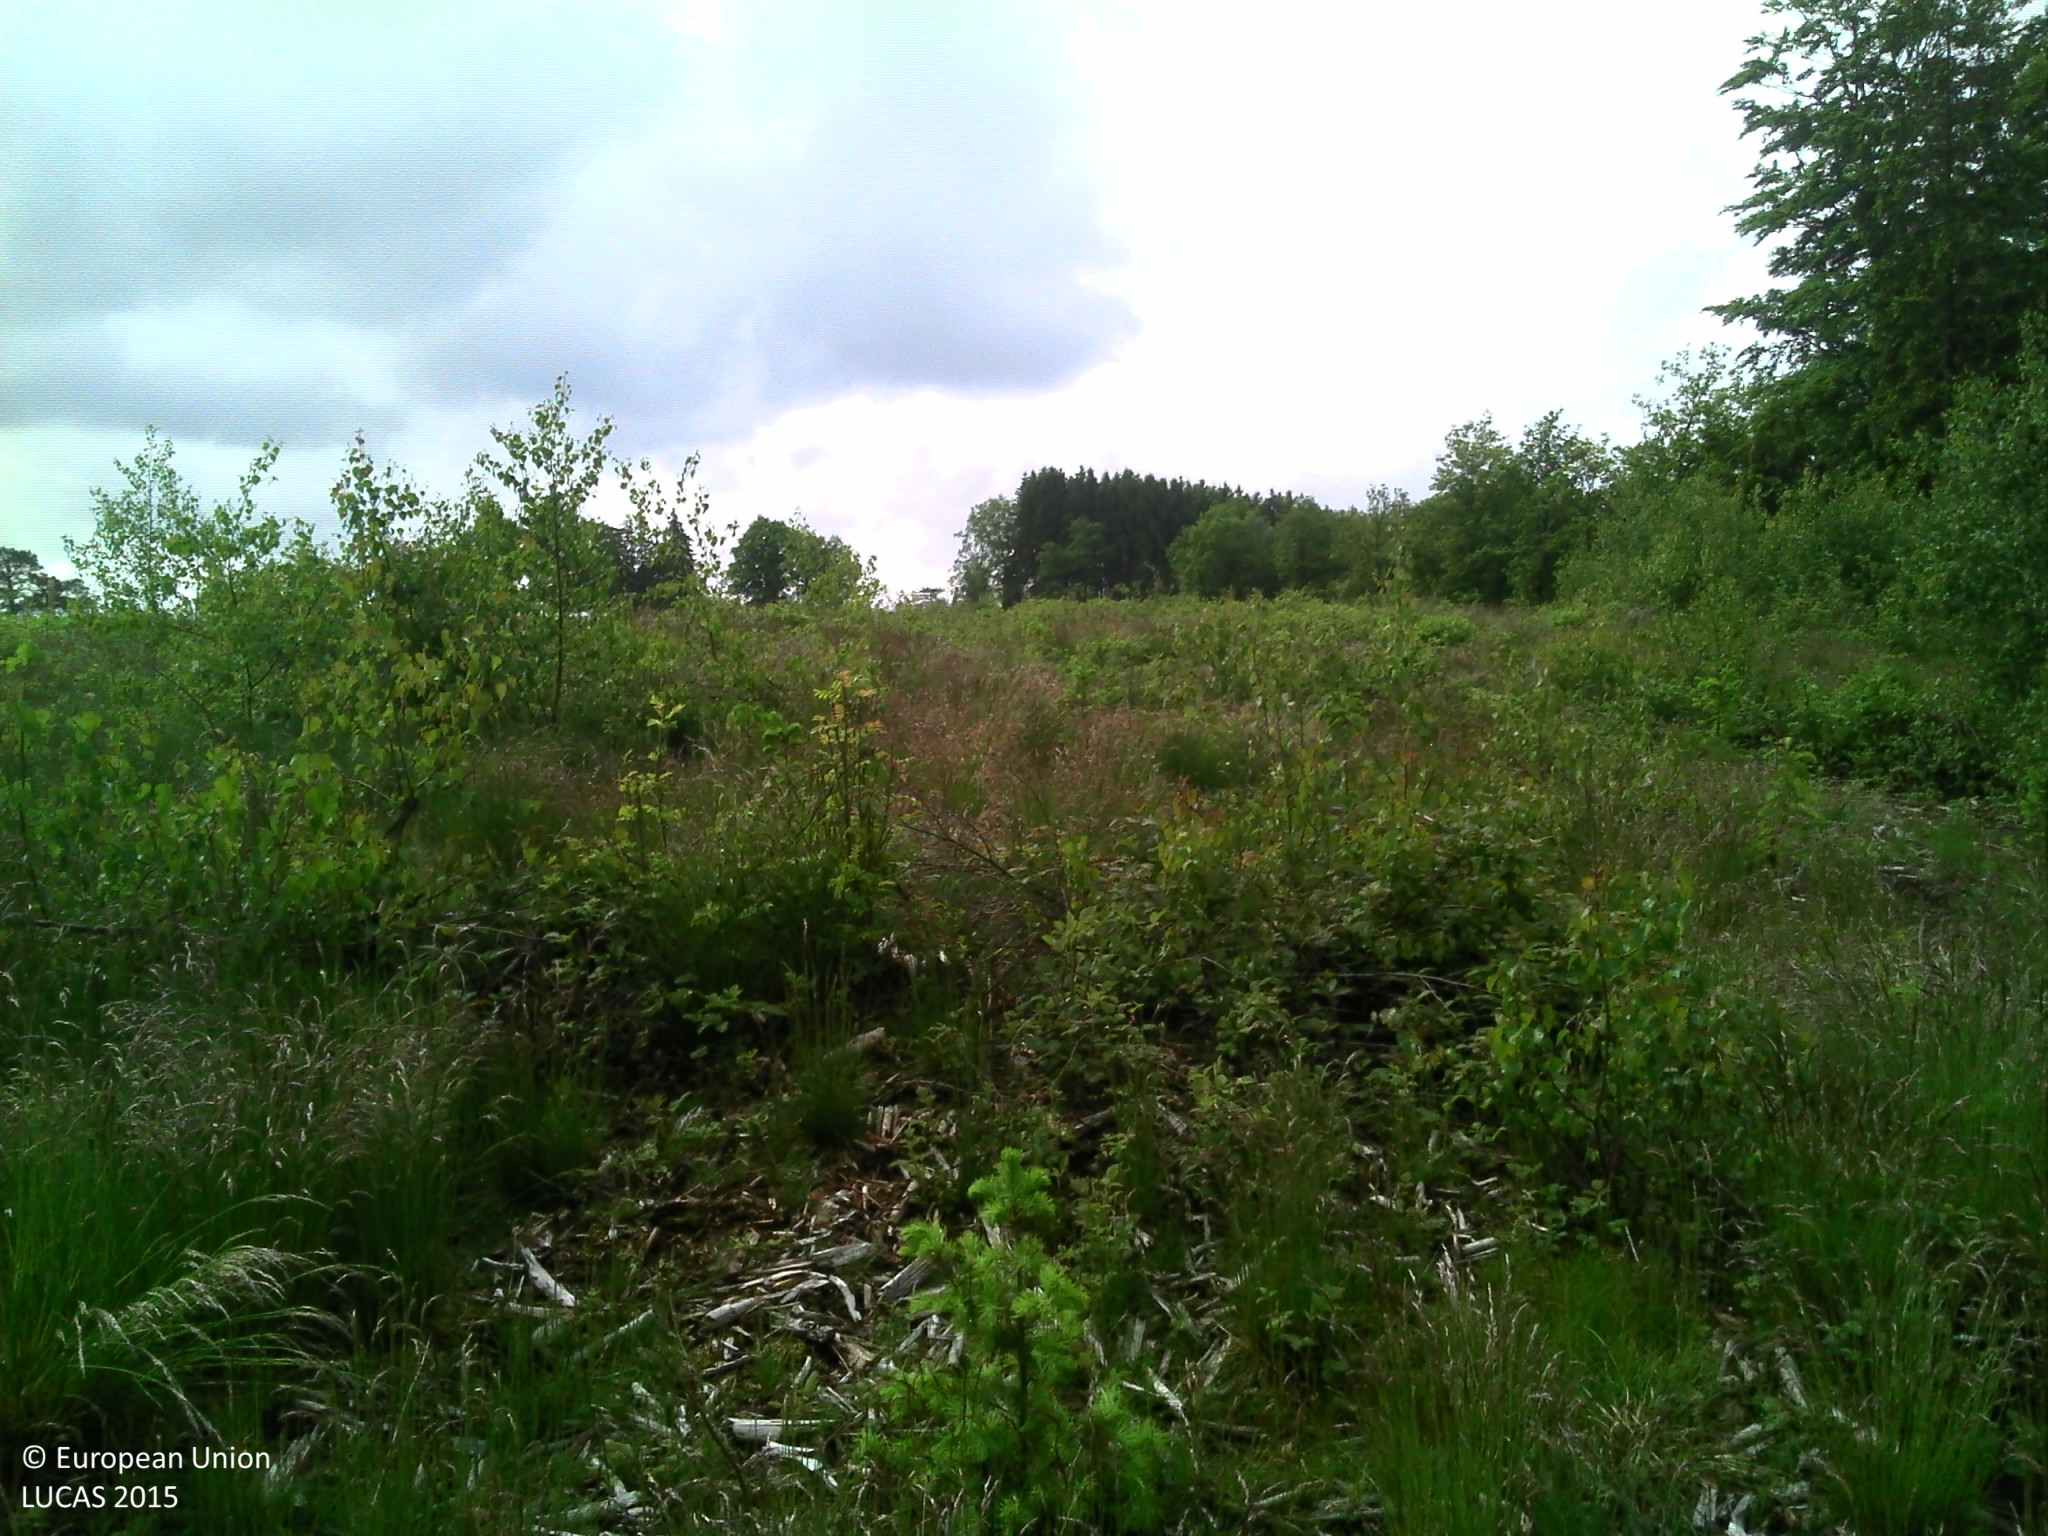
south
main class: Shrubland
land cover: Shrubland without tree cover
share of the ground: > 75 %
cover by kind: shrubs 60 %, herbaceous plants 40 %
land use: Forestry
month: June
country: BE
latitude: 50.2681
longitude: 5.7758
